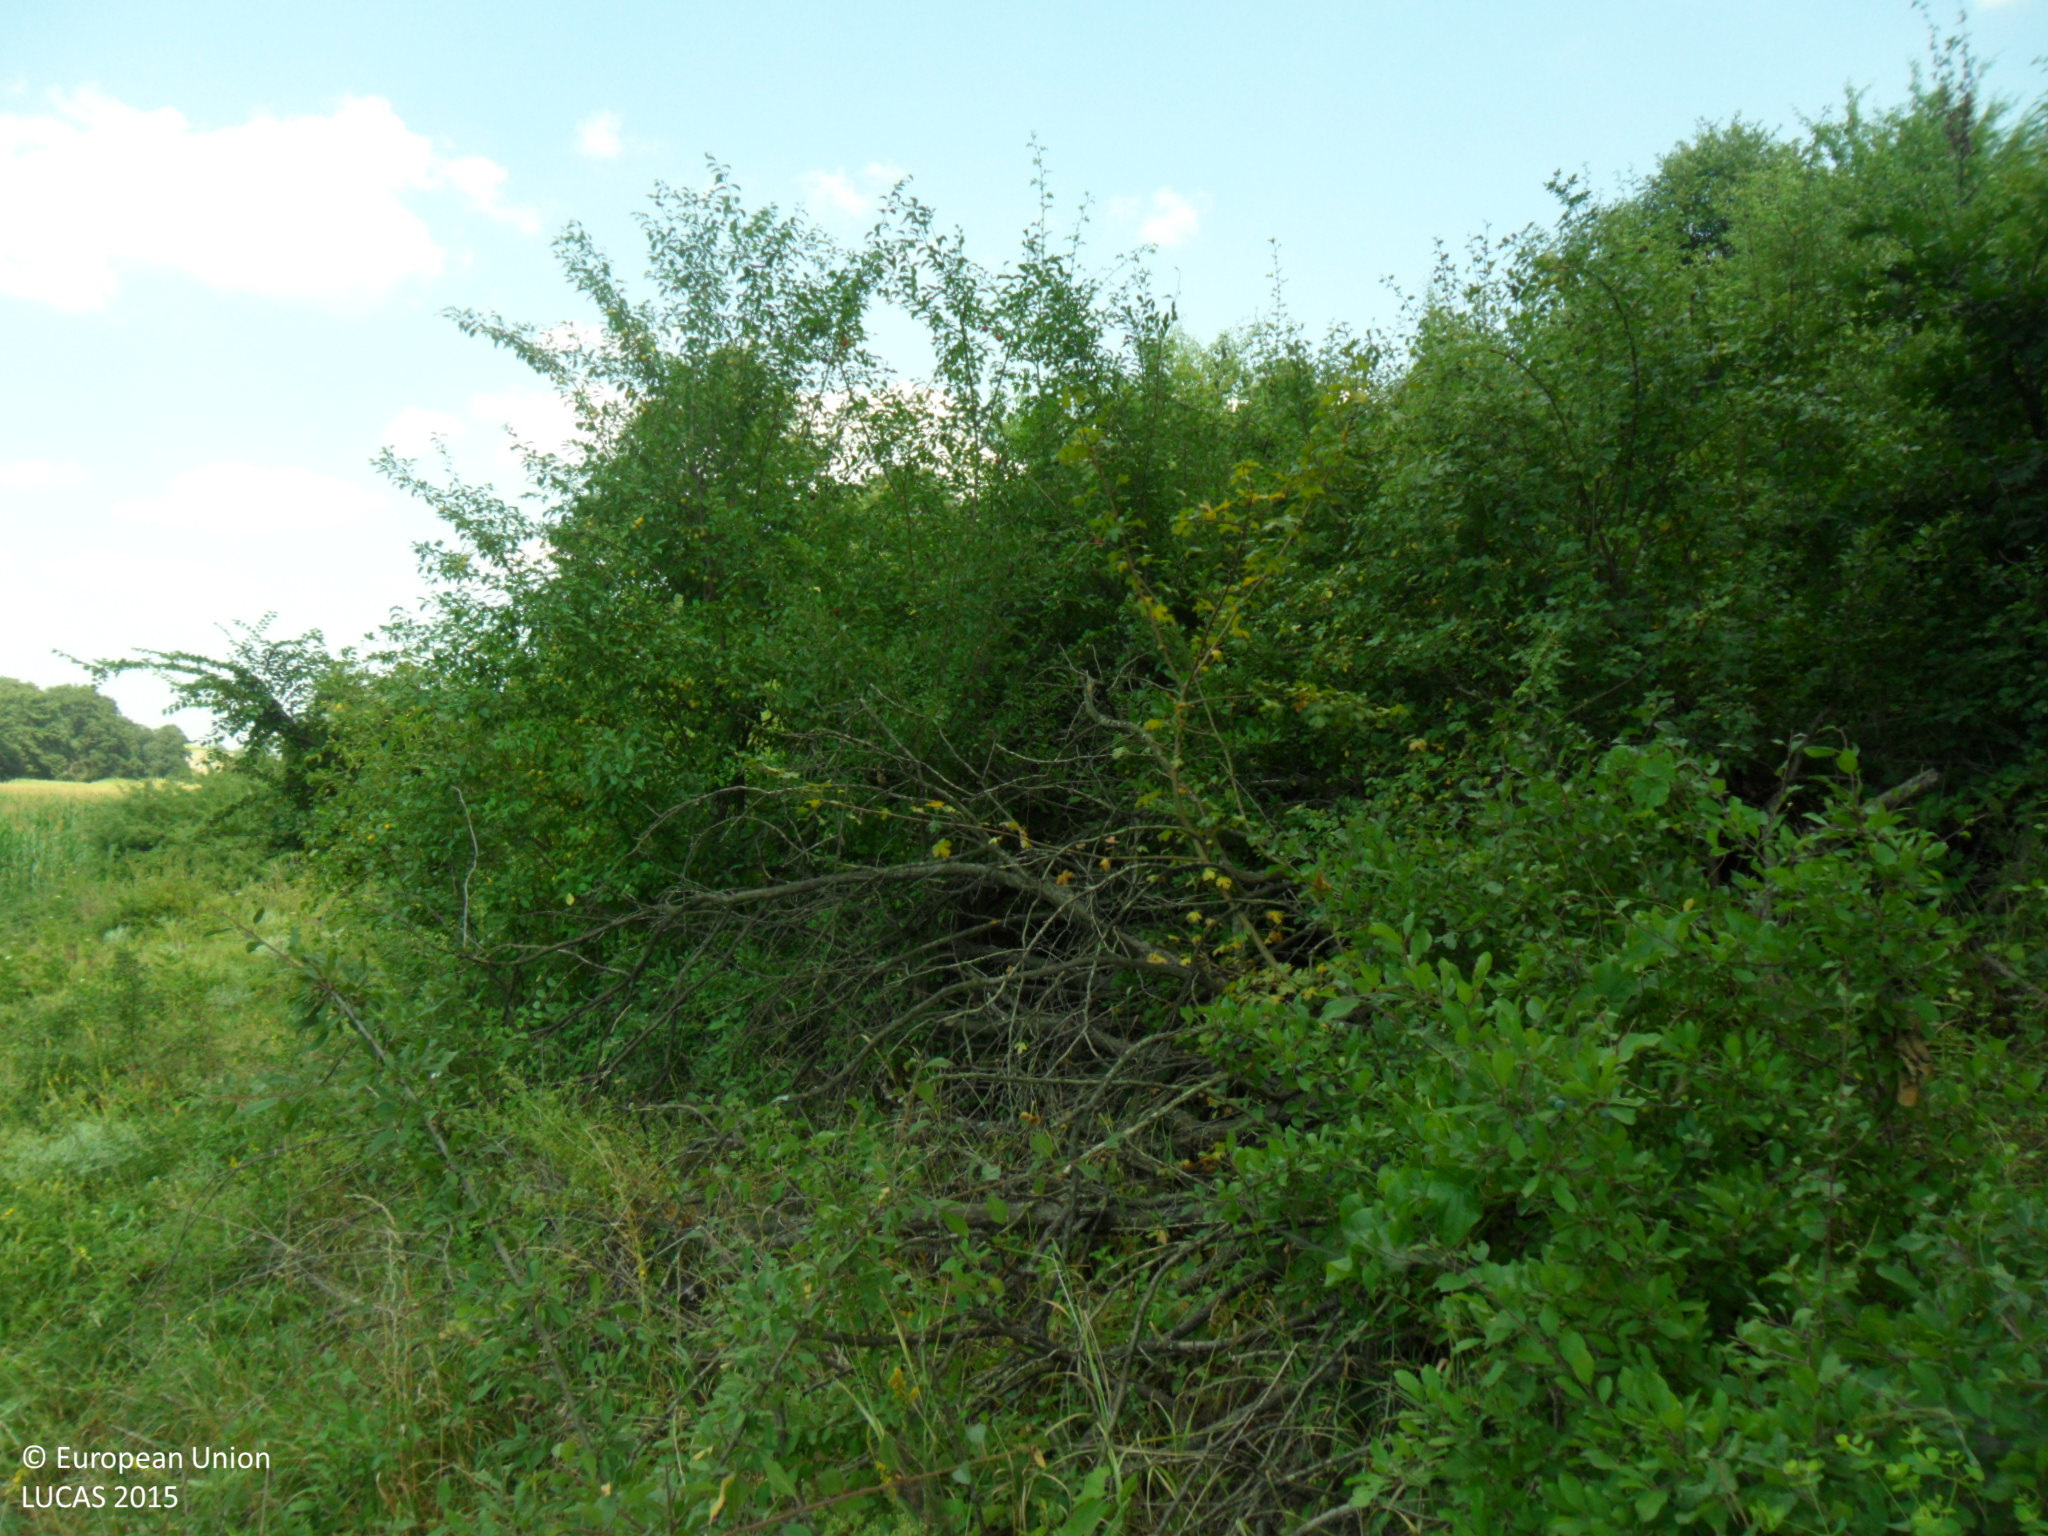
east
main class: Shrubland
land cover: Shrubland with sparse tree cover
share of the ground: > 75 %
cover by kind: shrubs 95 %, broadleaved forest trees 5 %
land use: Semi-natural and natural areas not in use
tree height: > 5 m
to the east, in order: Shrubland with sparse tree cover; Maize
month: July
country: BG
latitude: 43.5821
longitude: 27.2017
